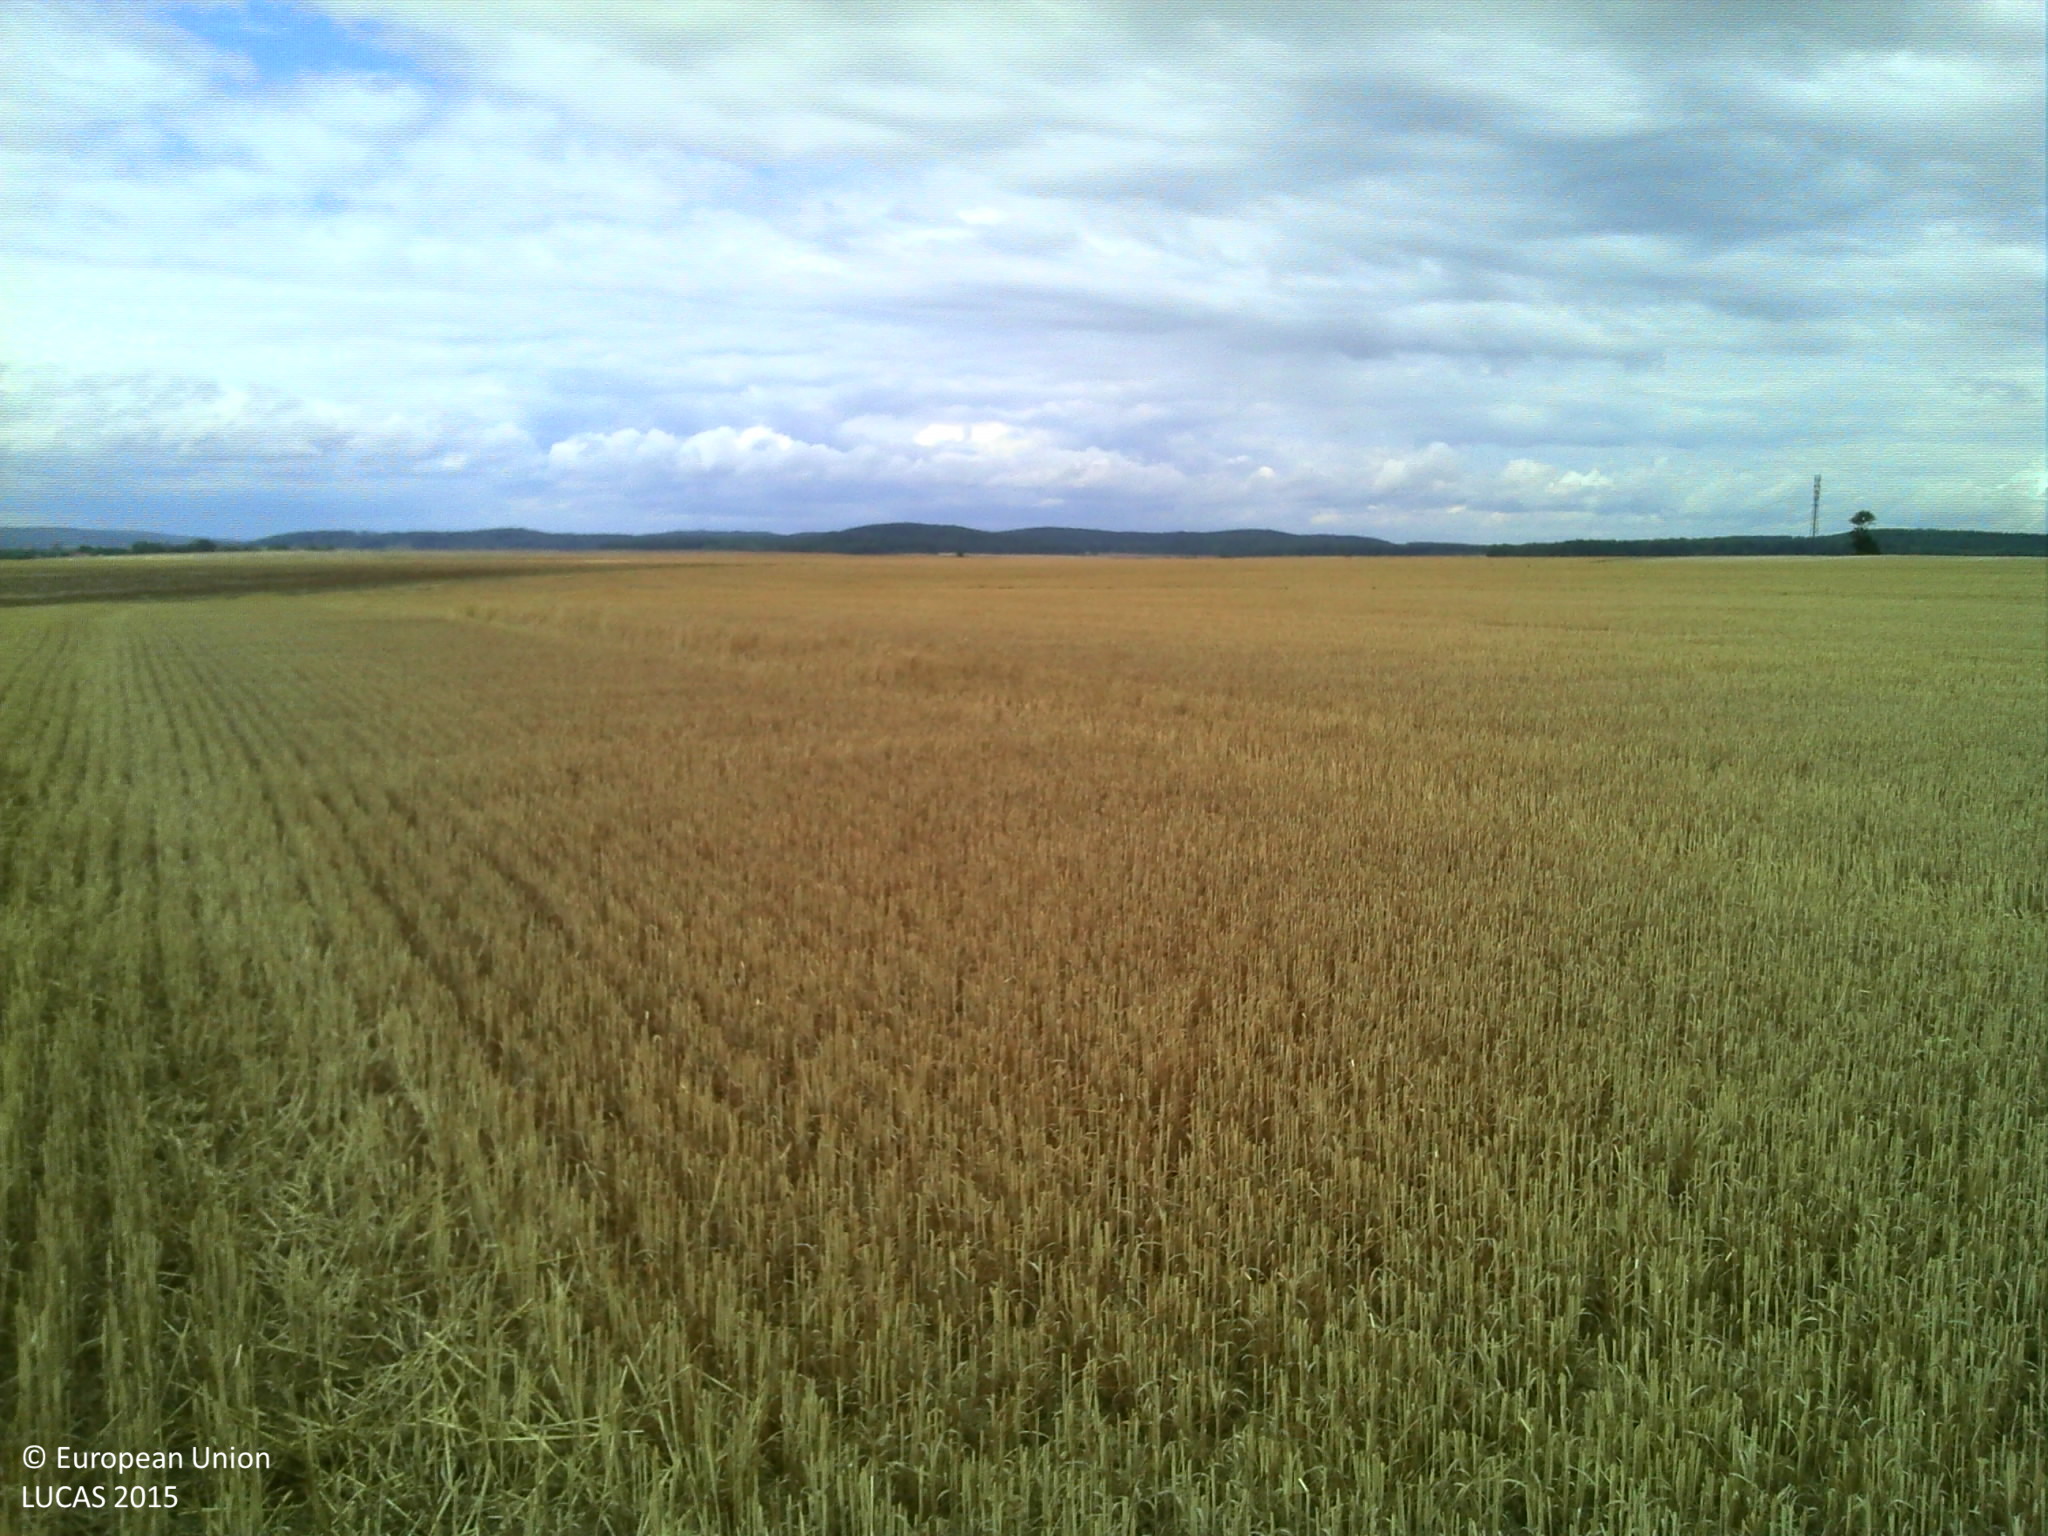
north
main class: Cropland
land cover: Common wheat
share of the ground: > 75 %
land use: Agriculture (excluding fallow land and kitchen gardens)
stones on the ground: < 10 %
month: July
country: FR
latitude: 49.1243
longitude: 5.1060
